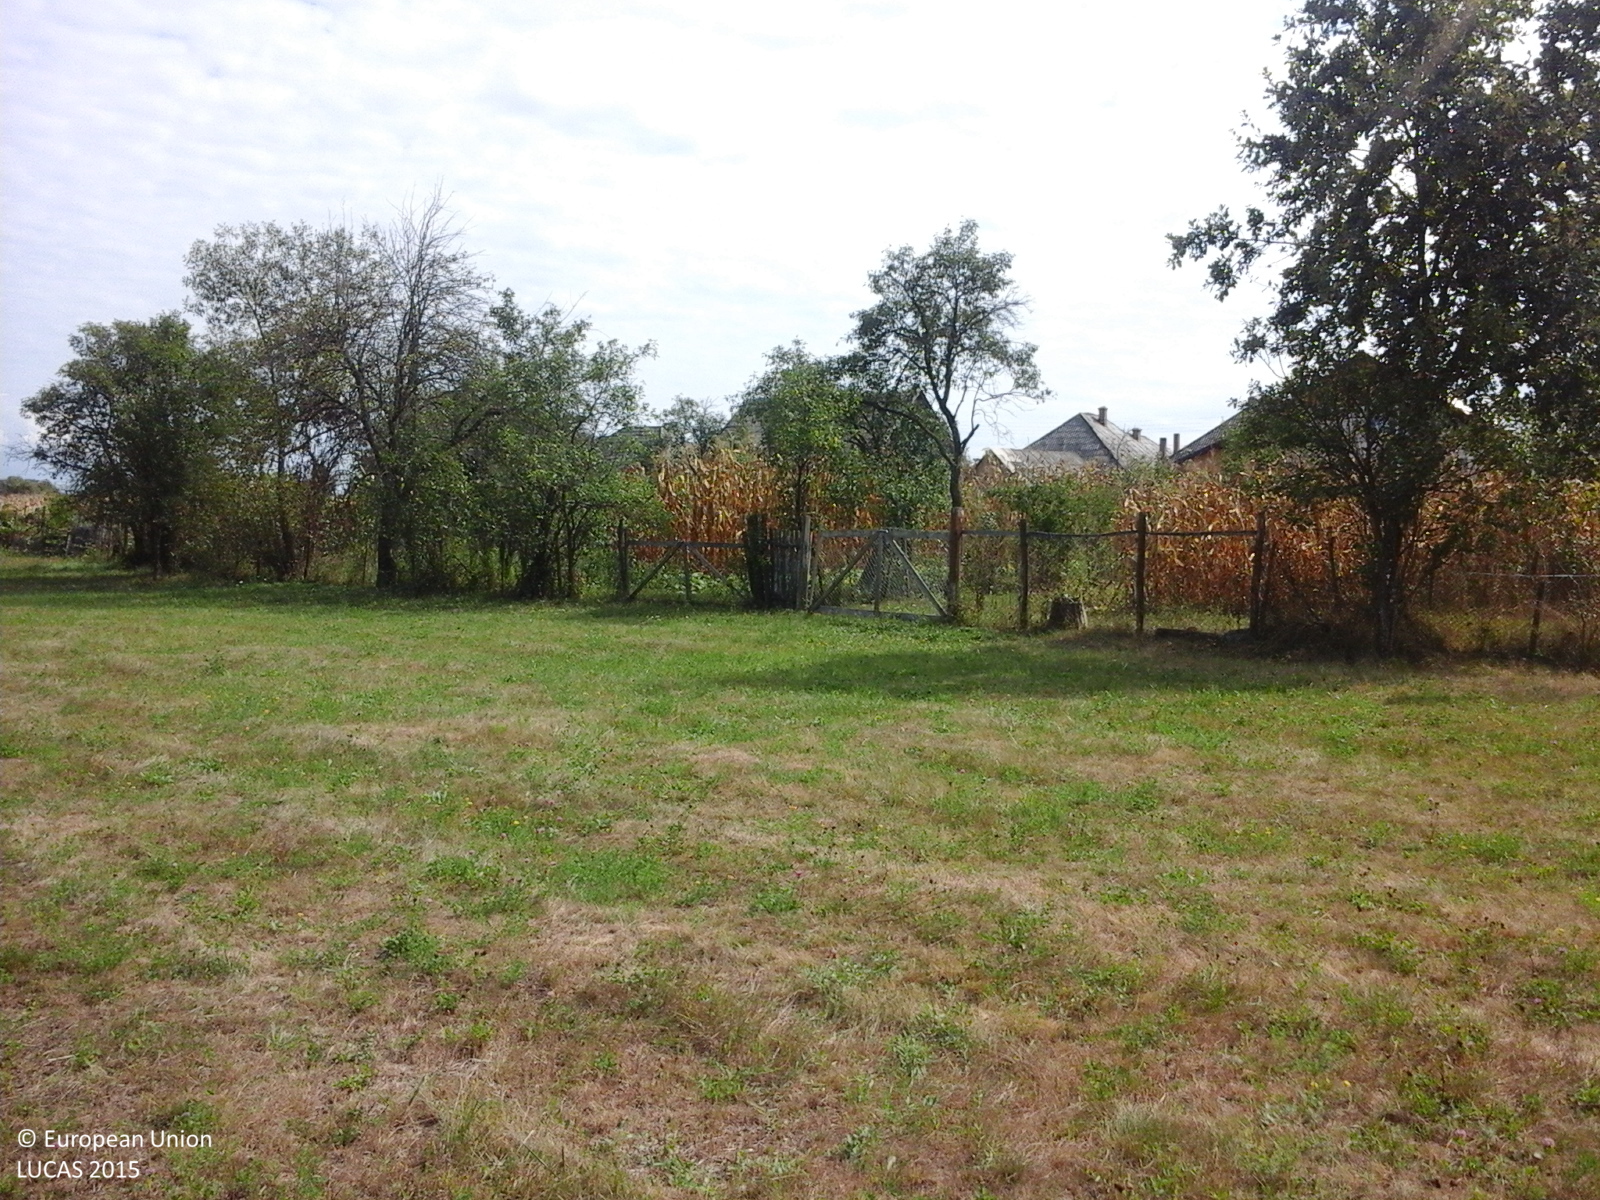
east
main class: Grassland
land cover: Grassland without tree/shrub cover
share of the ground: > 75 %
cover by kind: herbaceous plants 100 %
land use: Agriculture (excluding fallow land and kitchen gardens)
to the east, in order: Grassland without tree/shrub cover; Lines of trees; Fences; Grass margins; Maize; Artificial constructions in urban areas; Arable land (only in case pi); Grassland with sparse tree/shrub cover; Arable land (only in case pi)
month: September
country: RO
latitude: 47.5245
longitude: 23.2851
